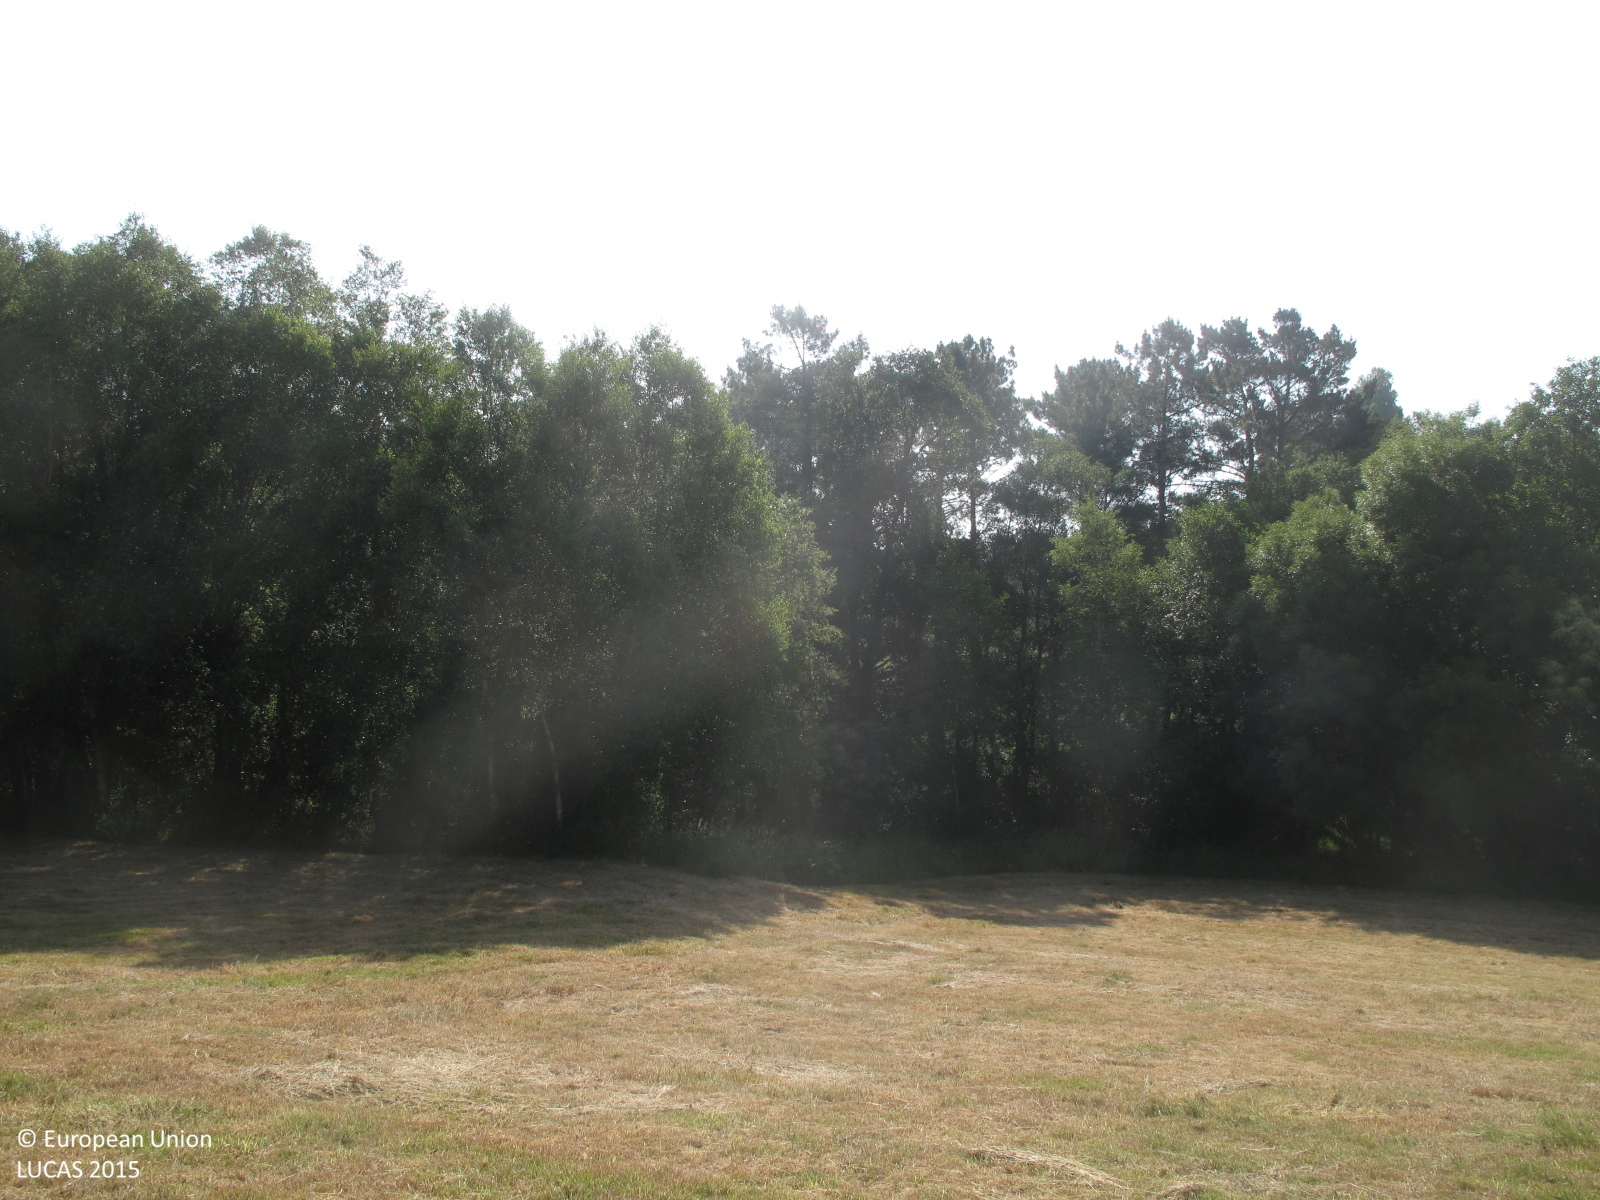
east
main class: Grassland
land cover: Grassland without tree/shrub cover
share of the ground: > 75 %
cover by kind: herbaceous plants 100 %
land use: Agriculture (excluding fallow land and kitchen gardens)
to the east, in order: Grassland without tree/shrub cover; Broadleaved woodland; Inland fresh running water; Broadleaved woodland; Pine dominated coniferous woodland; Shrubland with sparse tree cover
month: June
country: ES
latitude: 43.1463
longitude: -7.9057
